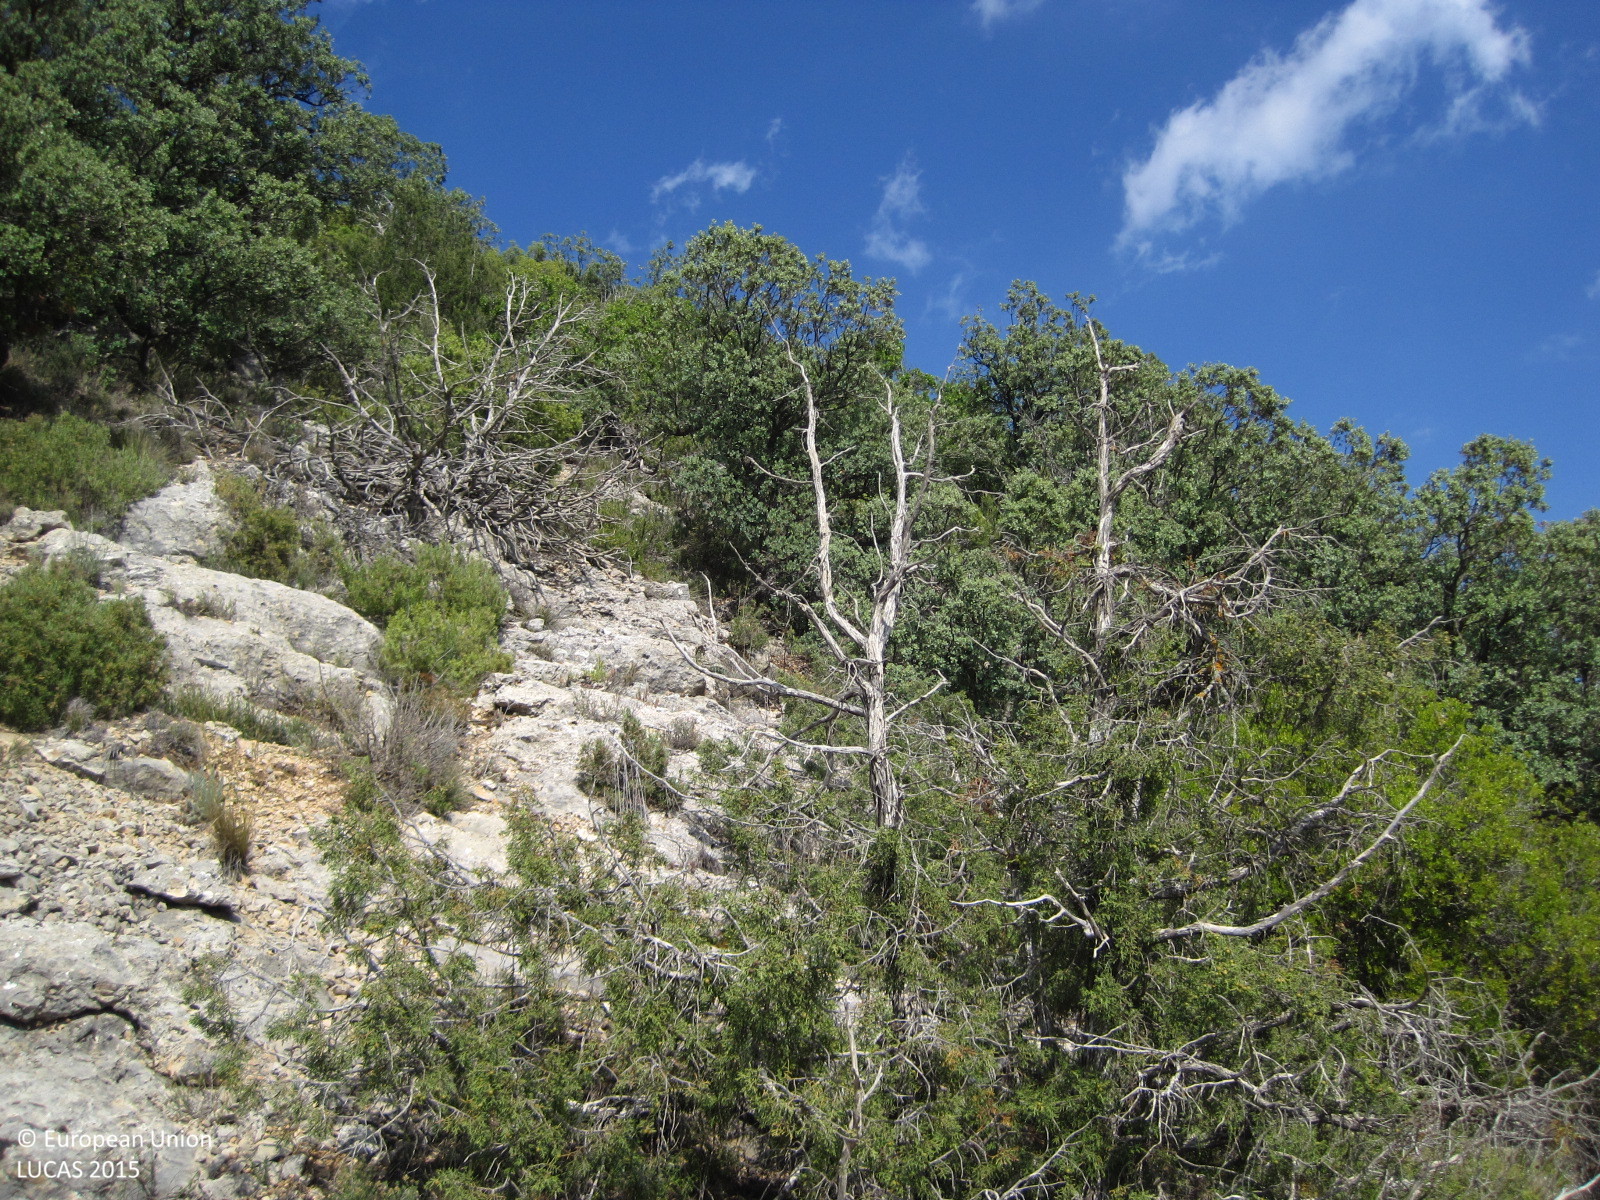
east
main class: Woodland
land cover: Pine dominated coniferous woodland
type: coniferous forest of the mediterranean region
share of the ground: 50 - 75 %
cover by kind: shrubs 50 %, coniferous forest trees 30 %, broadleaved forest trees 10 %, herbaceous plants 10 %
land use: Semi-natural and natural areas not in use
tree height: > 5 m
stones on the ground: > 50 %
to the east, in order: Pine dominated coniferous woodland; Shrubland with sparse tree cover; Broadleaved woodland
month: May
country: ES
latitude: 39.6473
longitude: -1.1559
